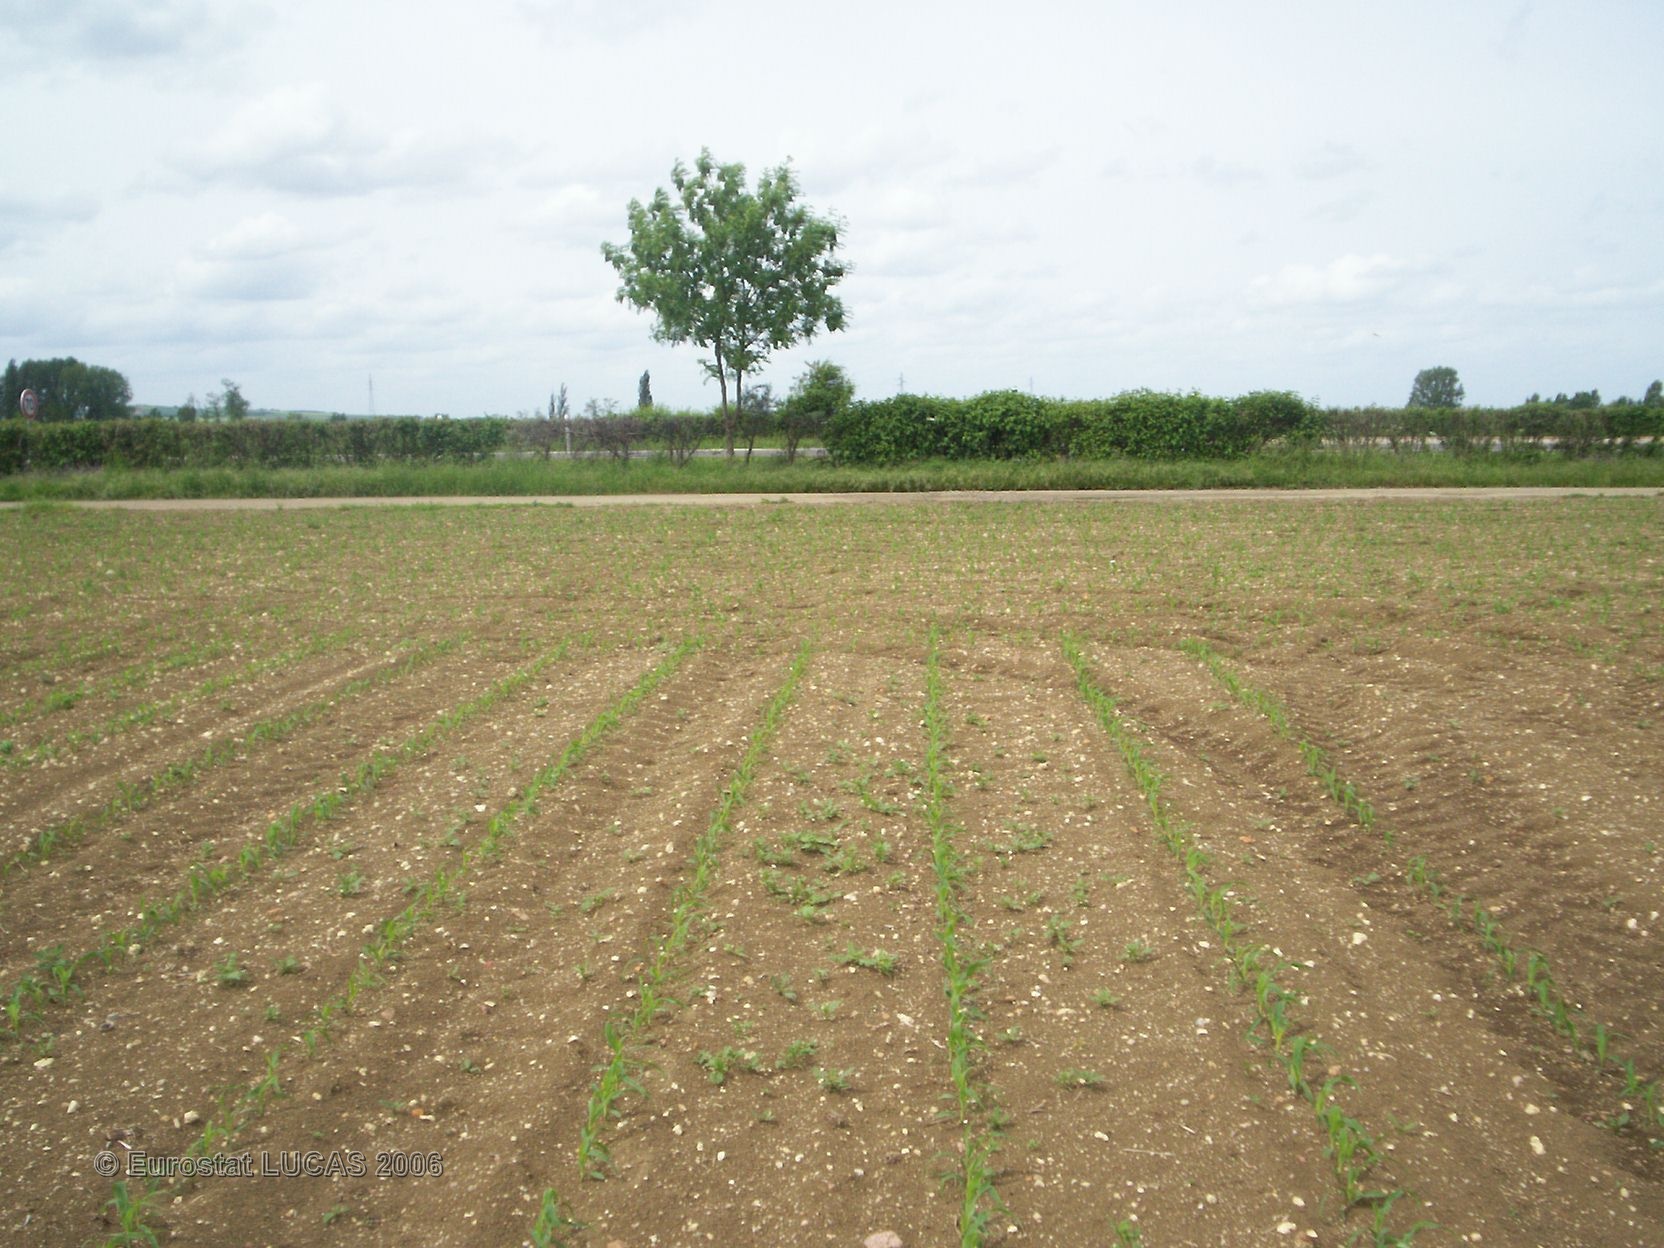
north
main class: Cropland
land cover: Maize
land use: Agriculture (excluding fallow land and kitchen gardens)
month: May
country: FR
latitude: 46.1007
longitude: 3.2337
